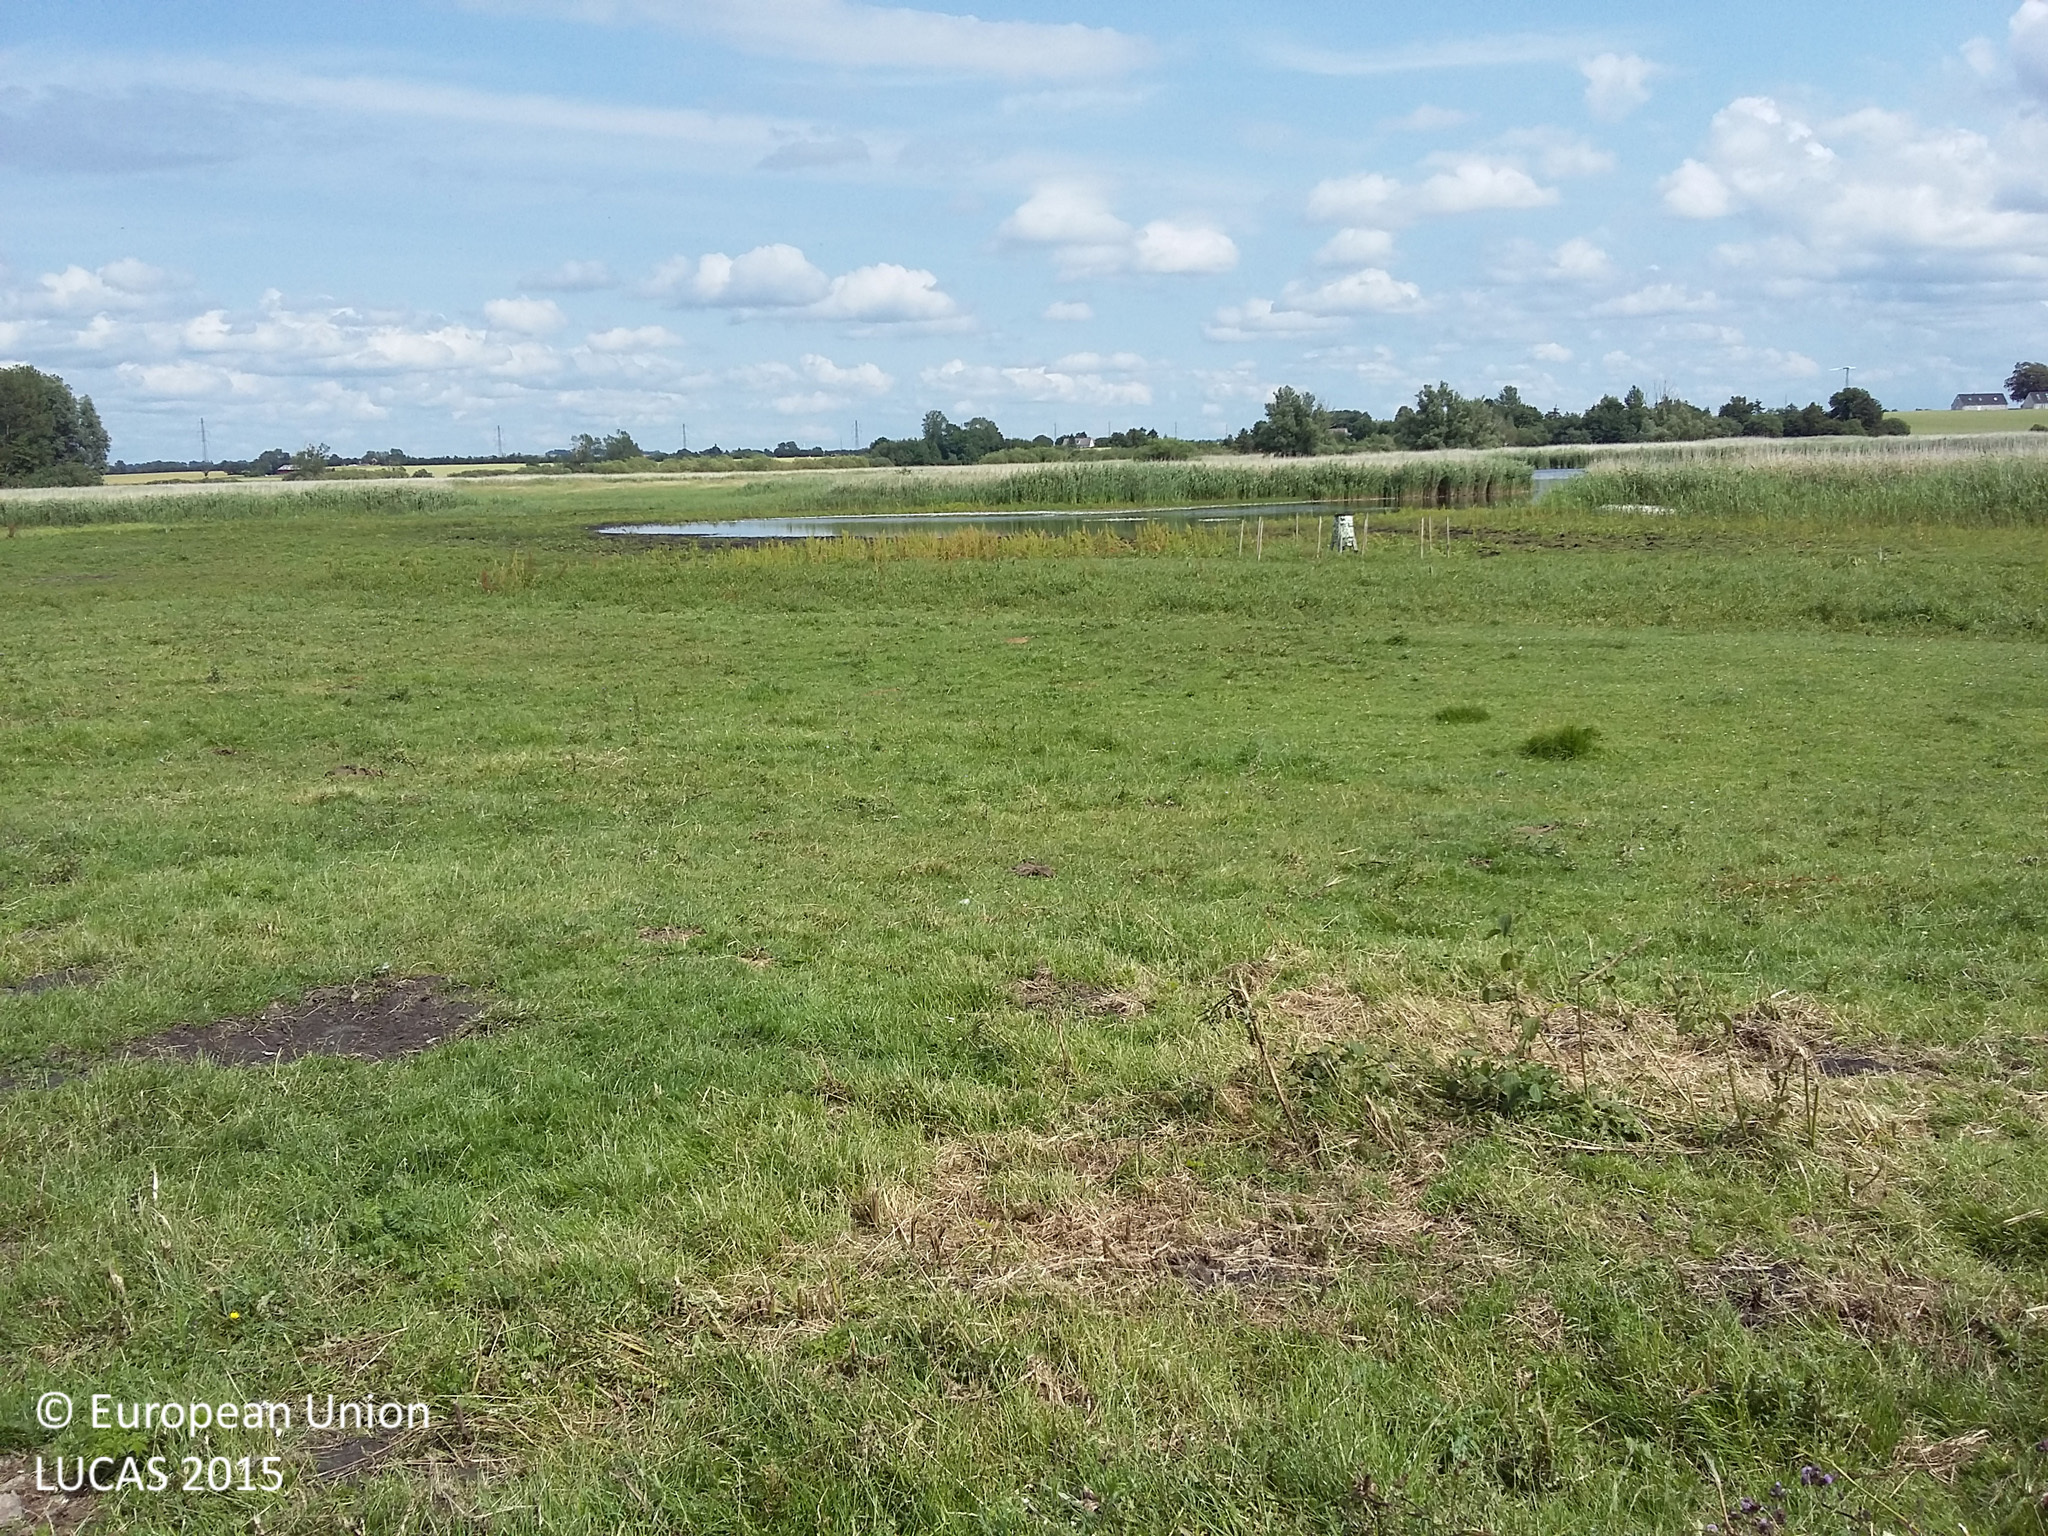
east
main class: Grassland
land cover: Grassland without tree/shrub cover
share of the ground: > 75 %
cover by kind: herbaceous plants 100 %
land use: Agriculture (excluding fallow land and kitchen gardens)
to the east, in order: Grassland without tree/shrub cover; Inland fresh water bodies; Inland marshes; Spontaneously vegetated surfaces
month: July
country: DK
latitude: 55.5345
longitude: 11.2506
